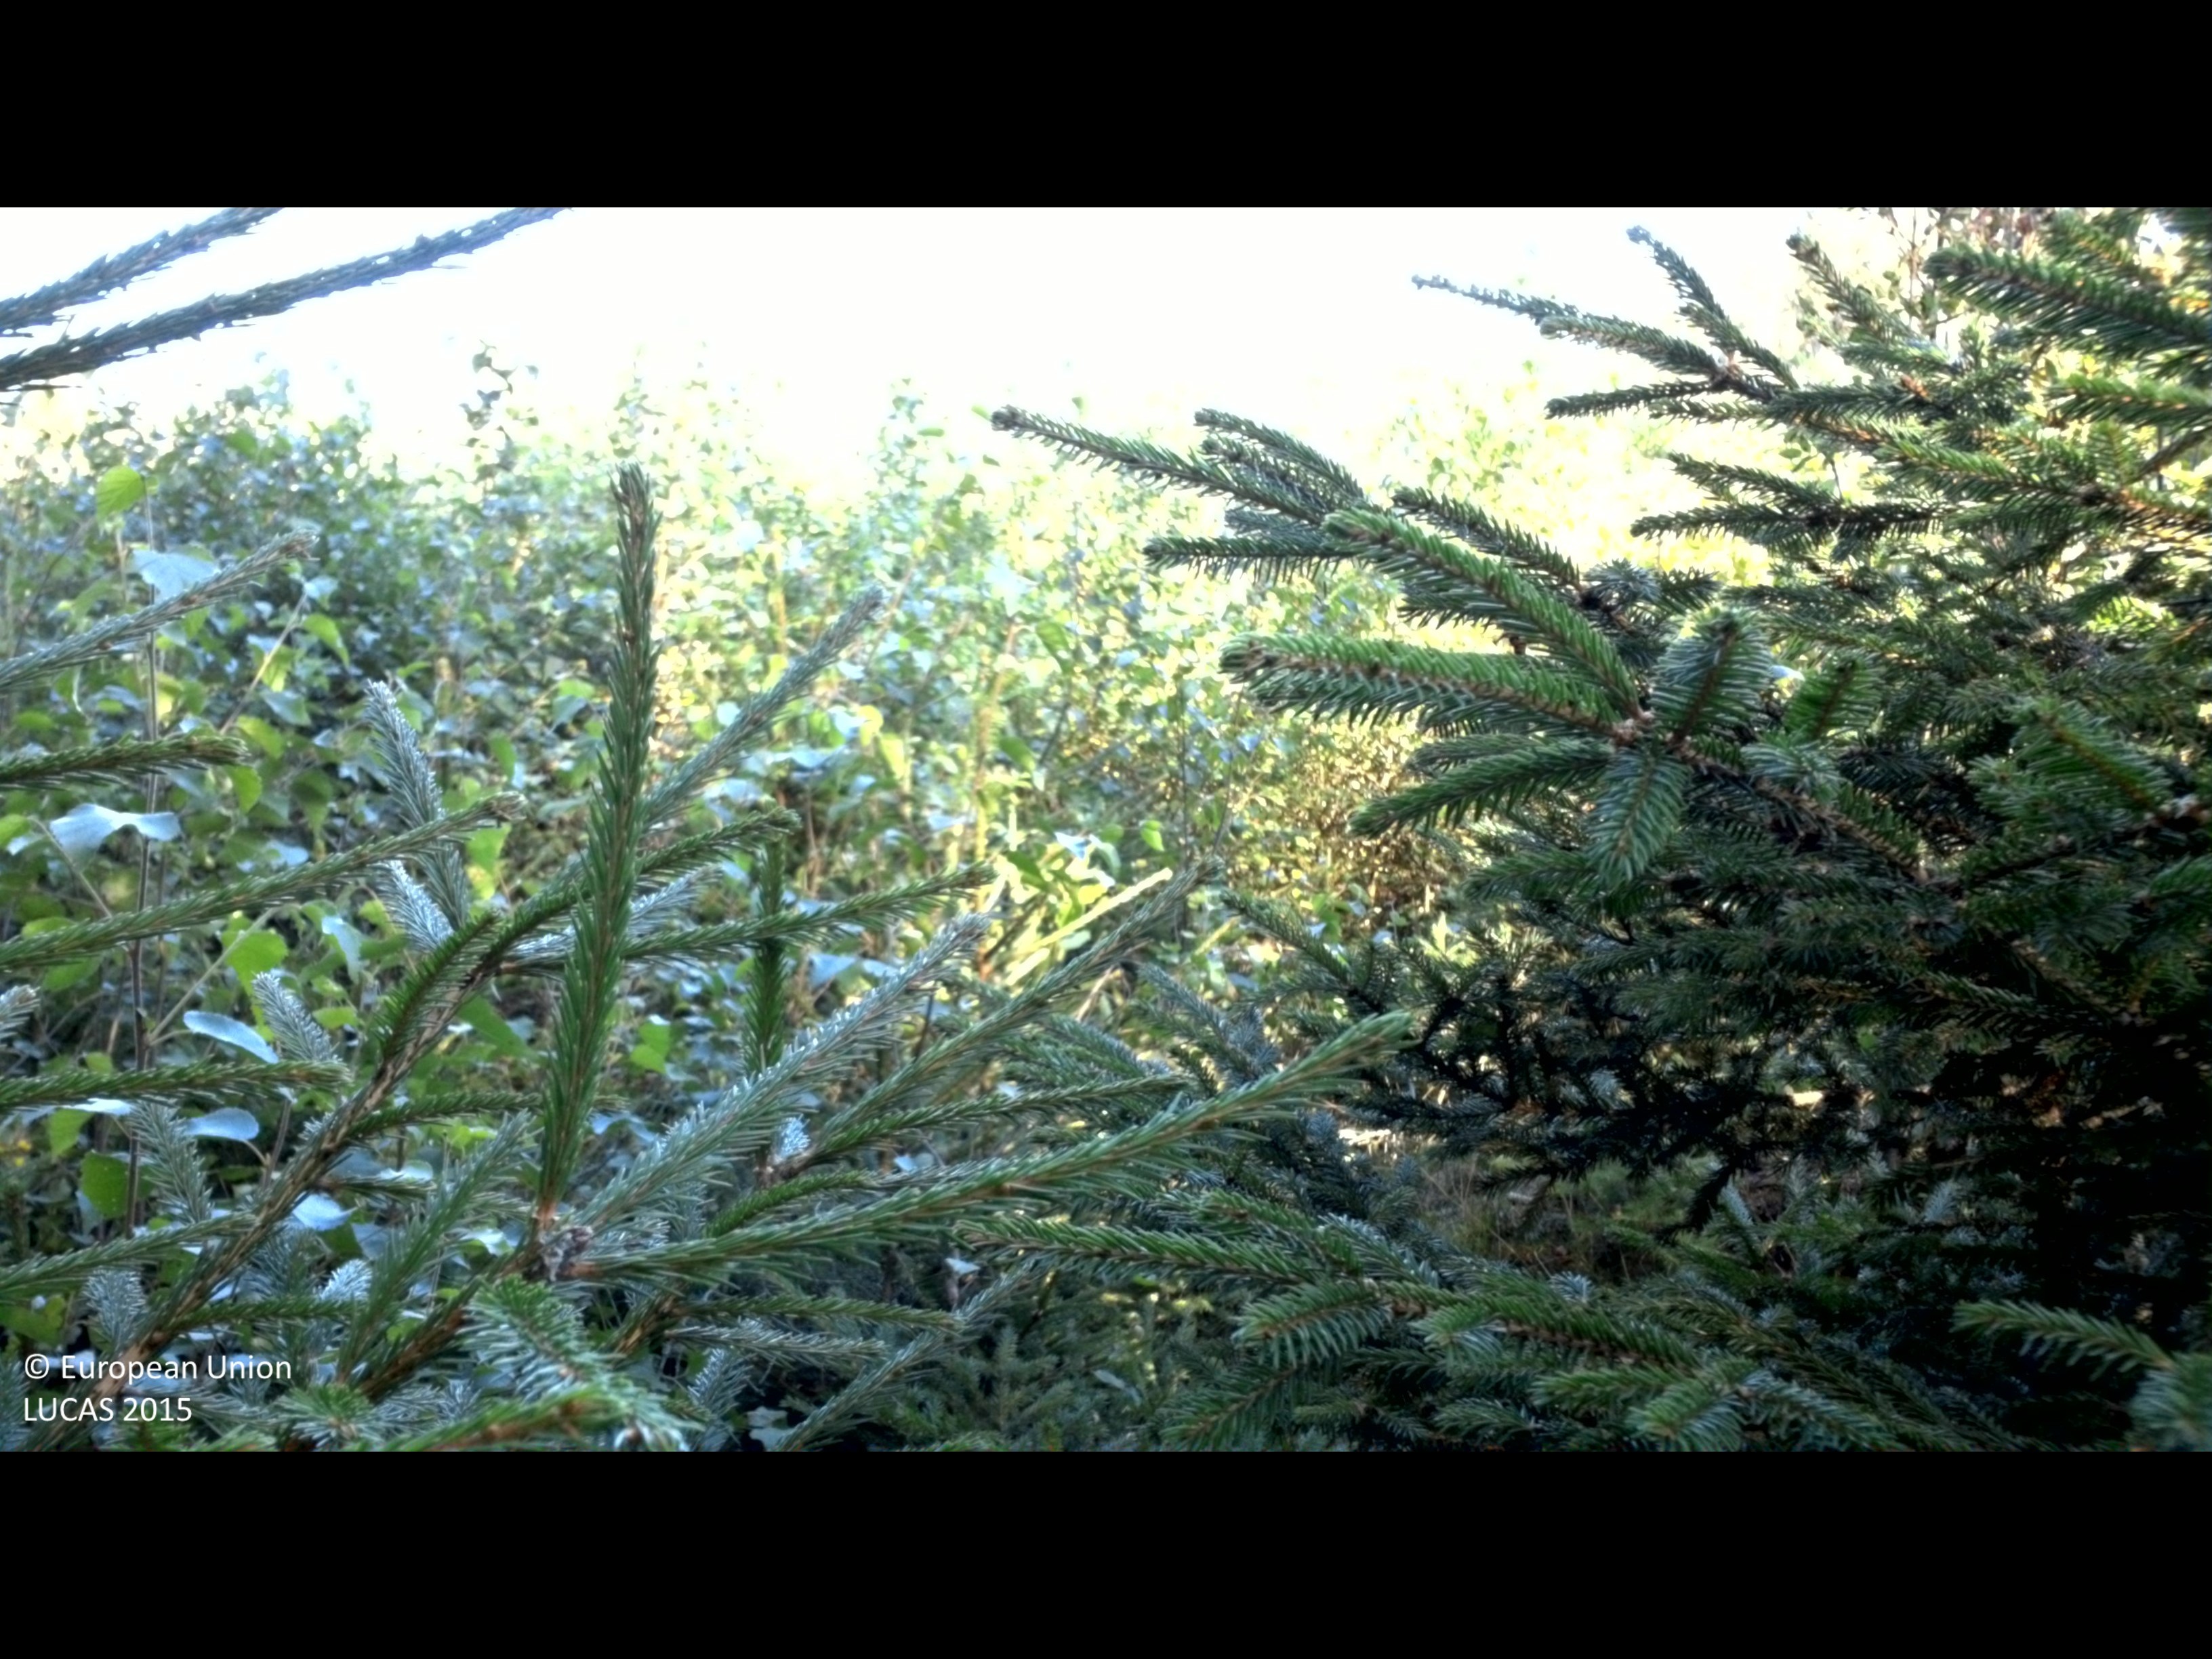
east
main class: Woodland
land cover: Spruce dominated mixed woodland
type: hemiboreal forest and nemoral coniferous forest and mixed broadleaved-coniferous forest
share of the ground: > 75 %
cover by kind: coniferous forest trees 50 %, broadleaved forest trees 25 %, herbaceous plants 20 %, shrubs 5 %
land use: Forestry
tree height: > 5 m
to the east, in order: Spruce dominated mixed woodland; Shrubland with sparse tree cover; Grassland with sparse tree/shrub cover; Spruce dominated mixed woodland; Spruce dominated coniferous woodland
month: August
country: SE
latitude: 56.2979
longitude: 15.2183
